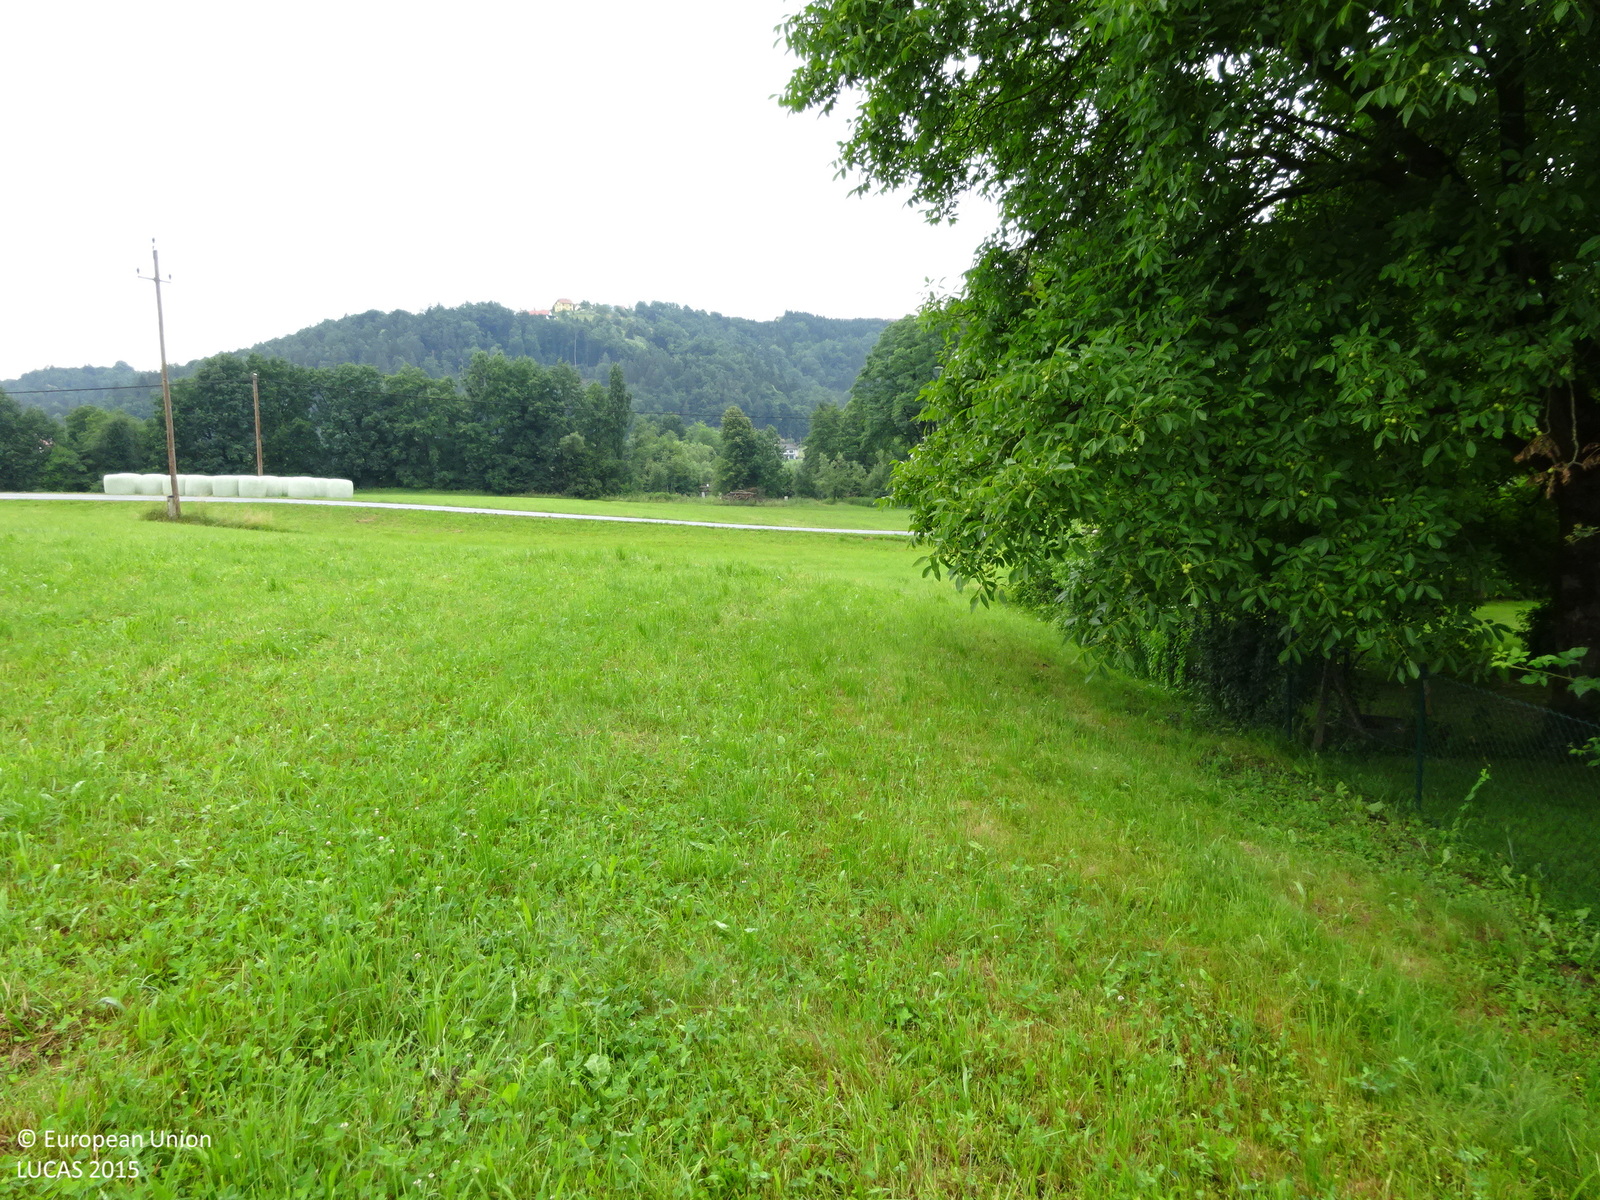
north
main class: Grassland
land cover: Grassland without tree/shrub cover
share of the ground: > 75 %
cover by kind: herbaceous plants 100 %
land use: Agriculture (excluding fallow land and kitchen gardens)
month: June
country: AT
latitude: 46.7560
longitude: 15.4060
